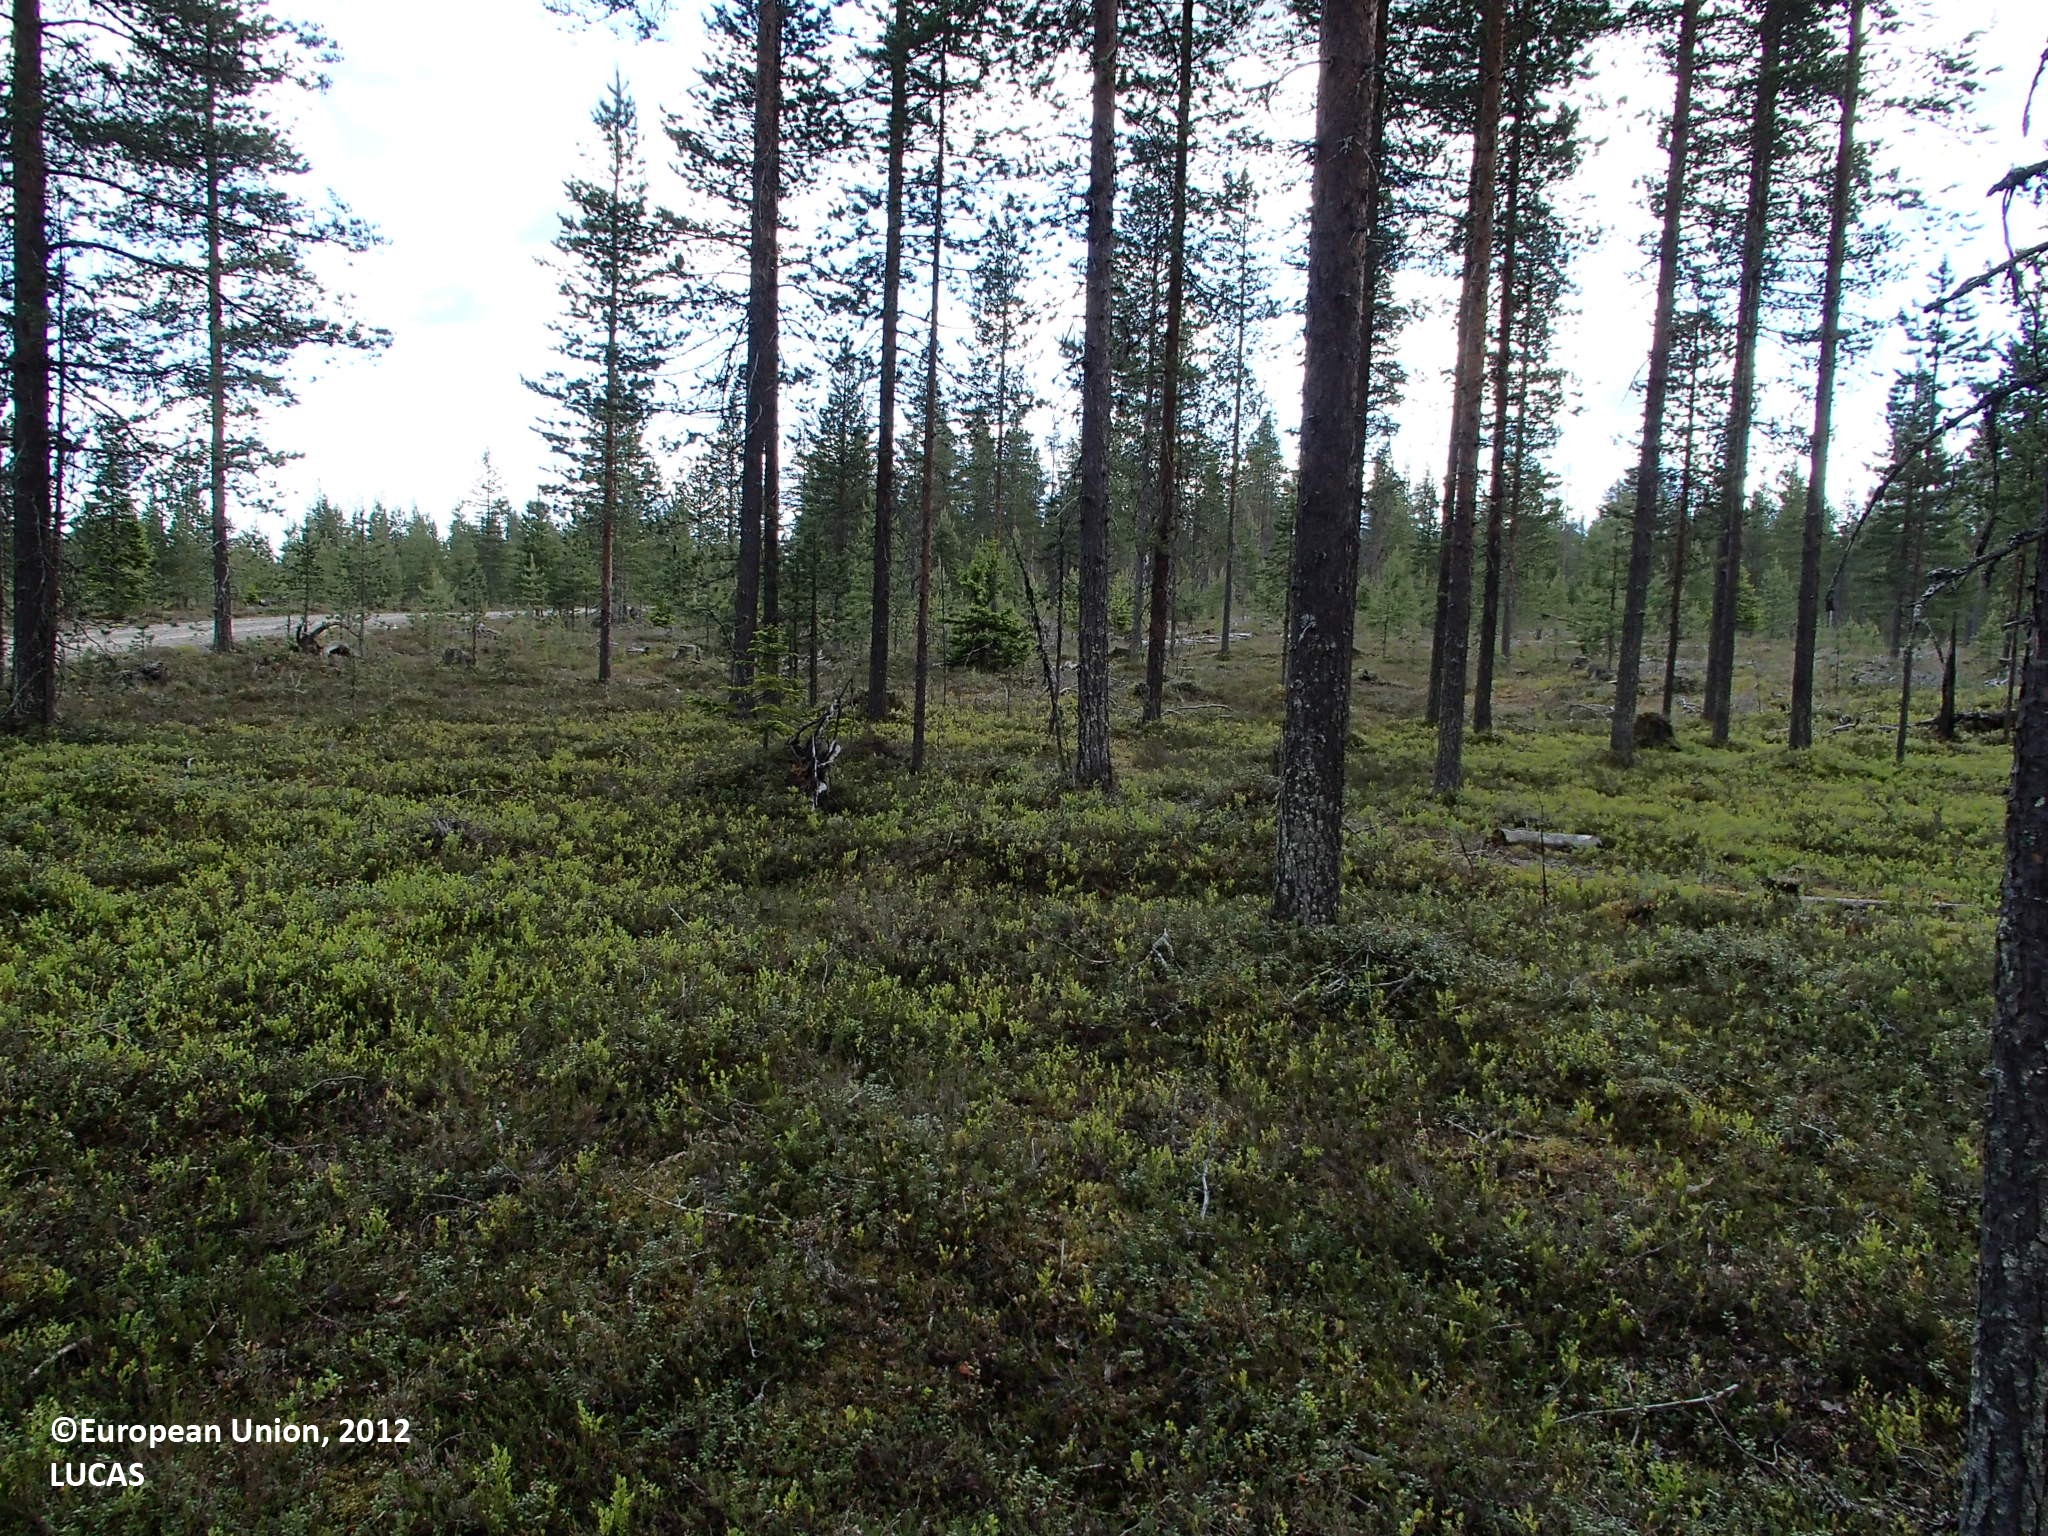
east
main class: Woodland
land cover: Pine dominated coniferous woodland
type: boreal forest
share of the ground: > 75 %
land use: Forestry
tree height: > 5 m
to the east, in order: Pine dominated coniferous woodland; Ditches and canals; Paved roads, cycling and walking lanes; Ditches and canals; Pine dominated coniferous woodland; Tracks; Pine dominated coniferous woodland
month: June
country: FI
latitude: 66.4565
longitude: 27.0863
